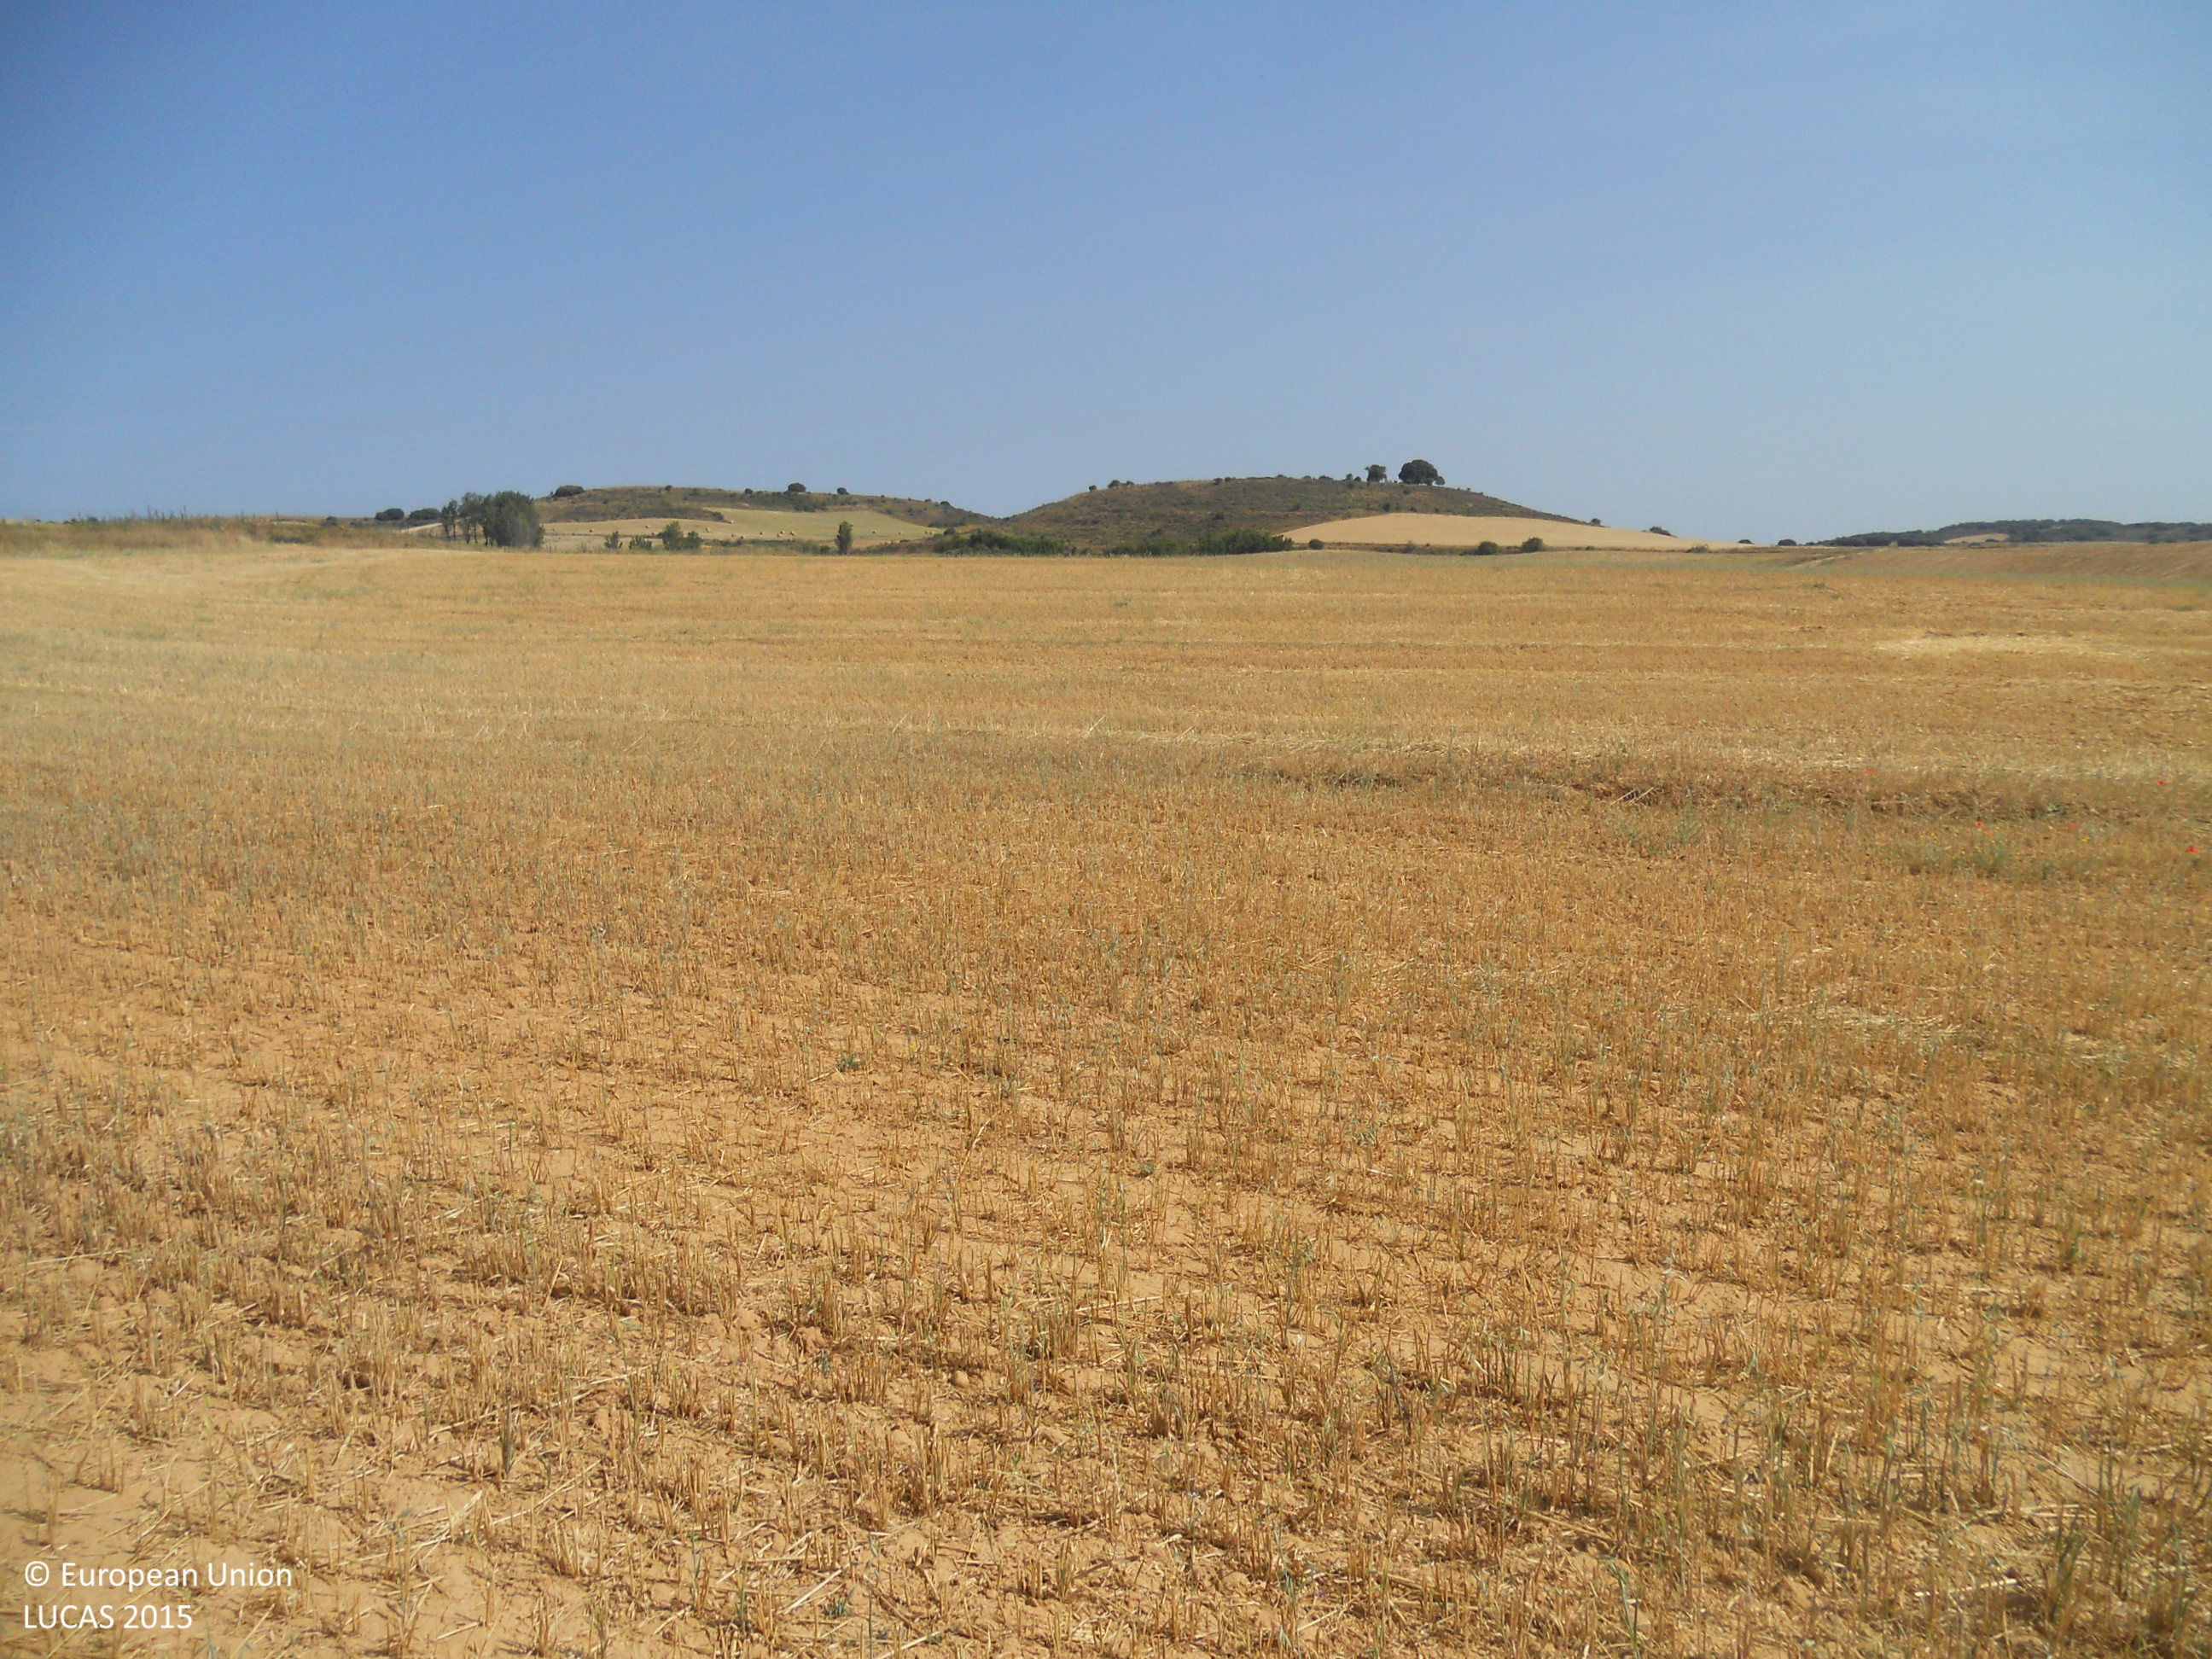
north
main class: Cropland
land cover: Oats
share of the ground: < 10 %
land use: Agriculture (excluding fallow land and kitchen gardens)
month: July
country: ES
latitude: 42.5616
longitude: -5.3295
